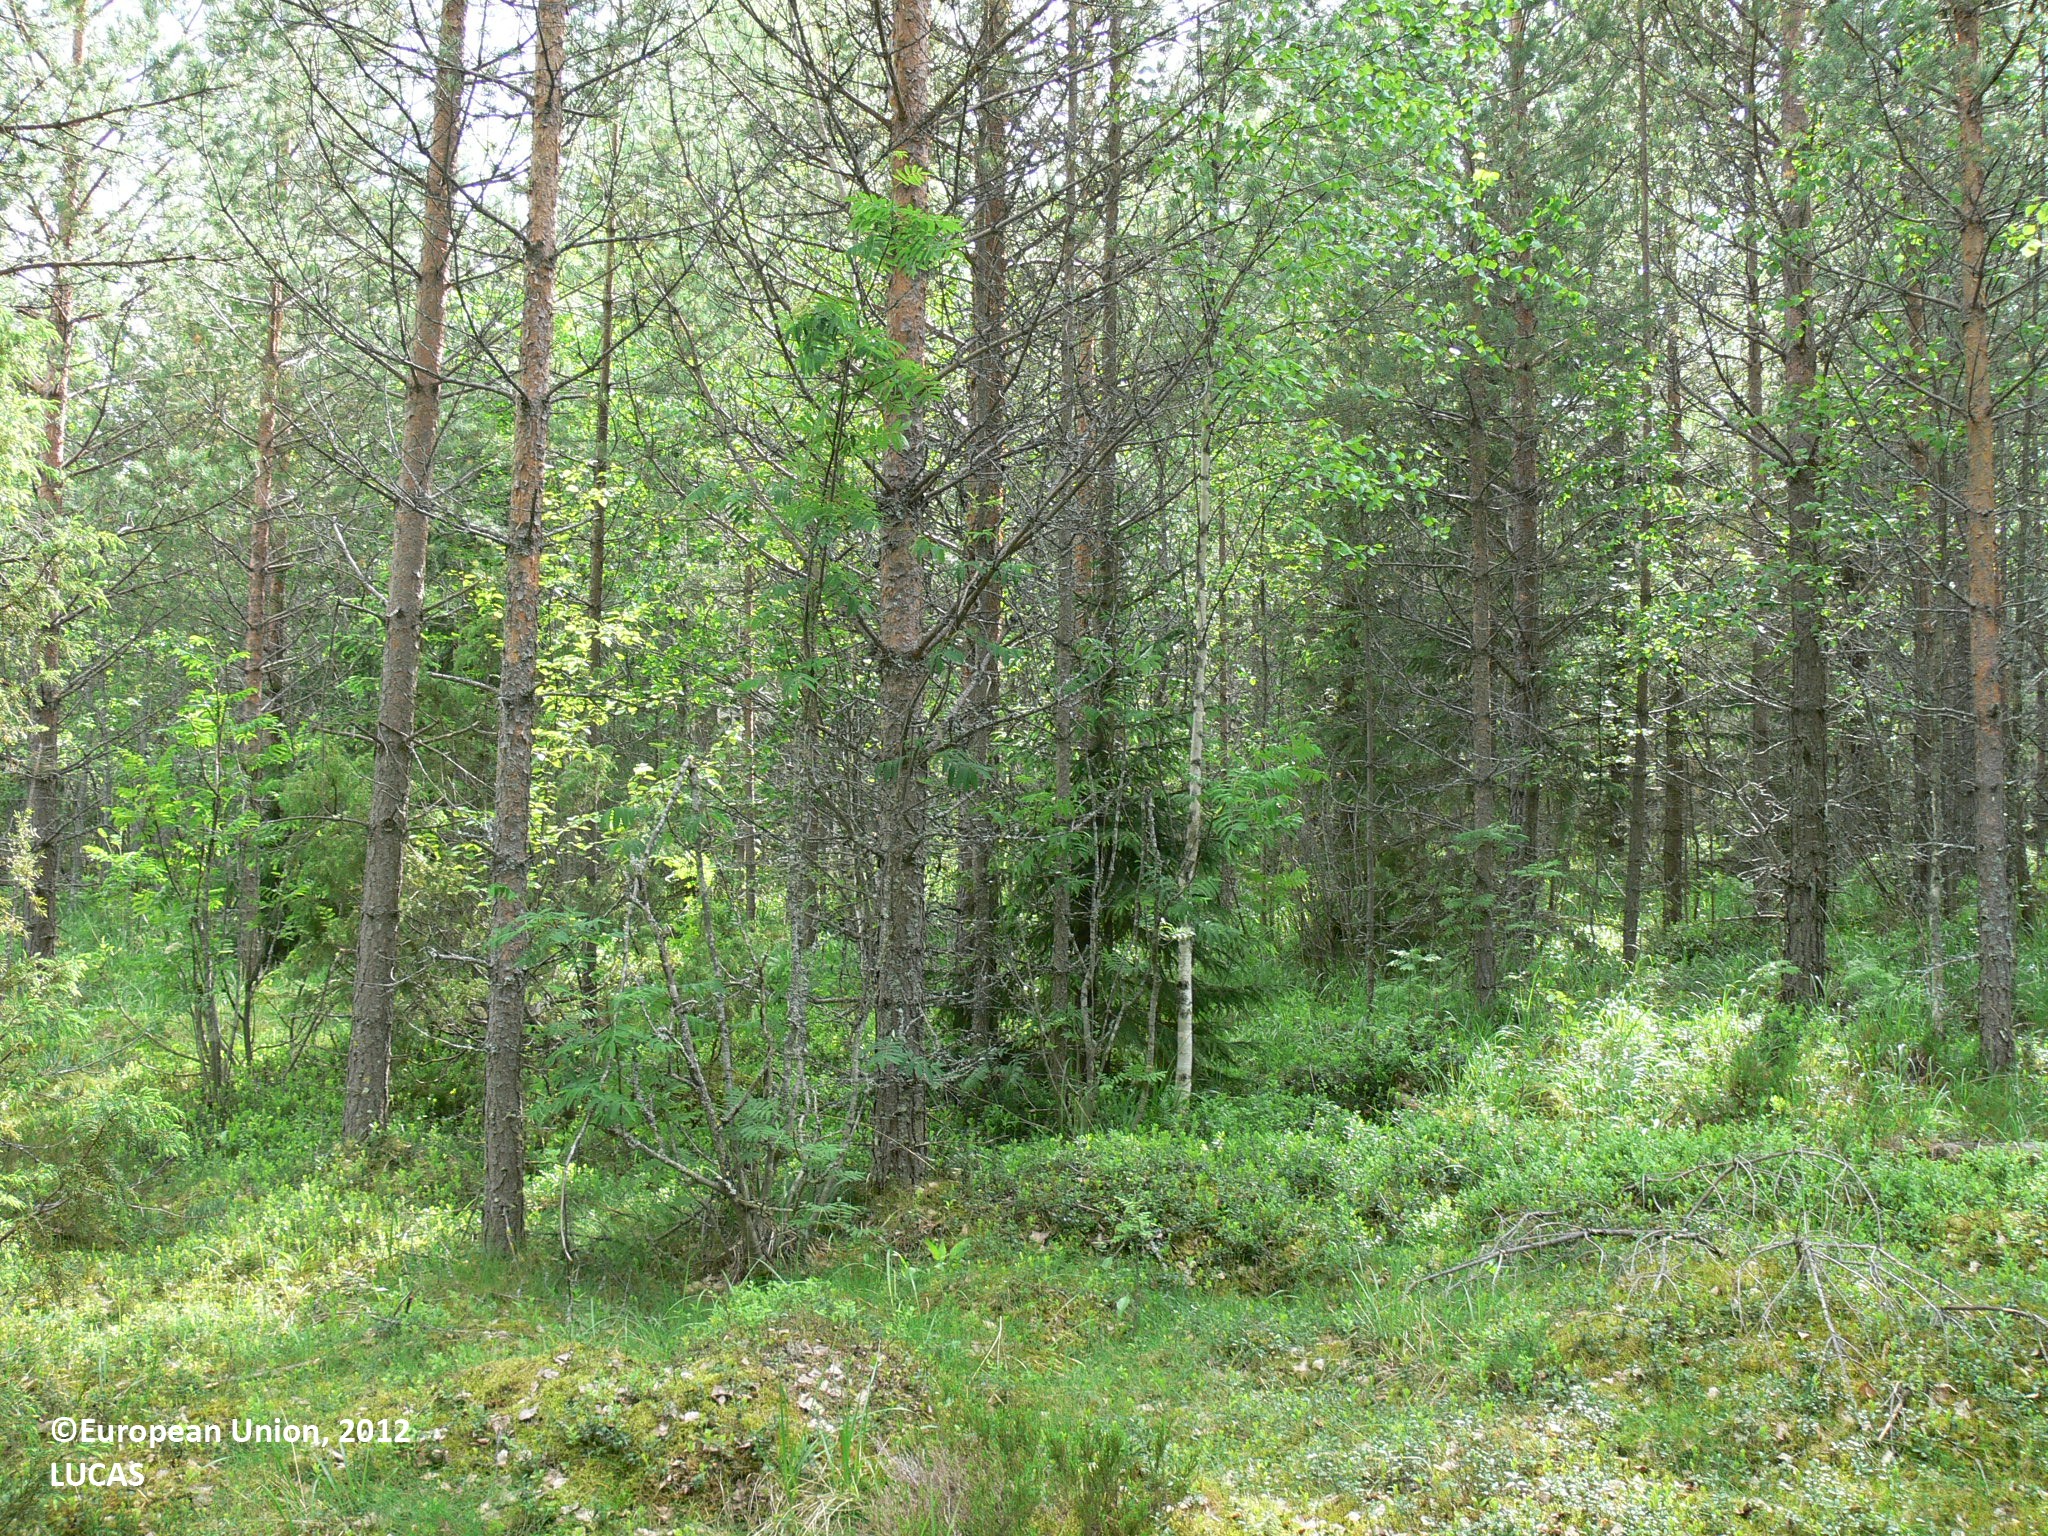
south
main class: Woodland
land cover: Other mixed woodland
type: boreal forest
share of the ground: 50 - 75 %
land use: Forestry
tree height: > 5 m
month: June
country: FI
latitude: 62.7340
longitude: 30.4908
